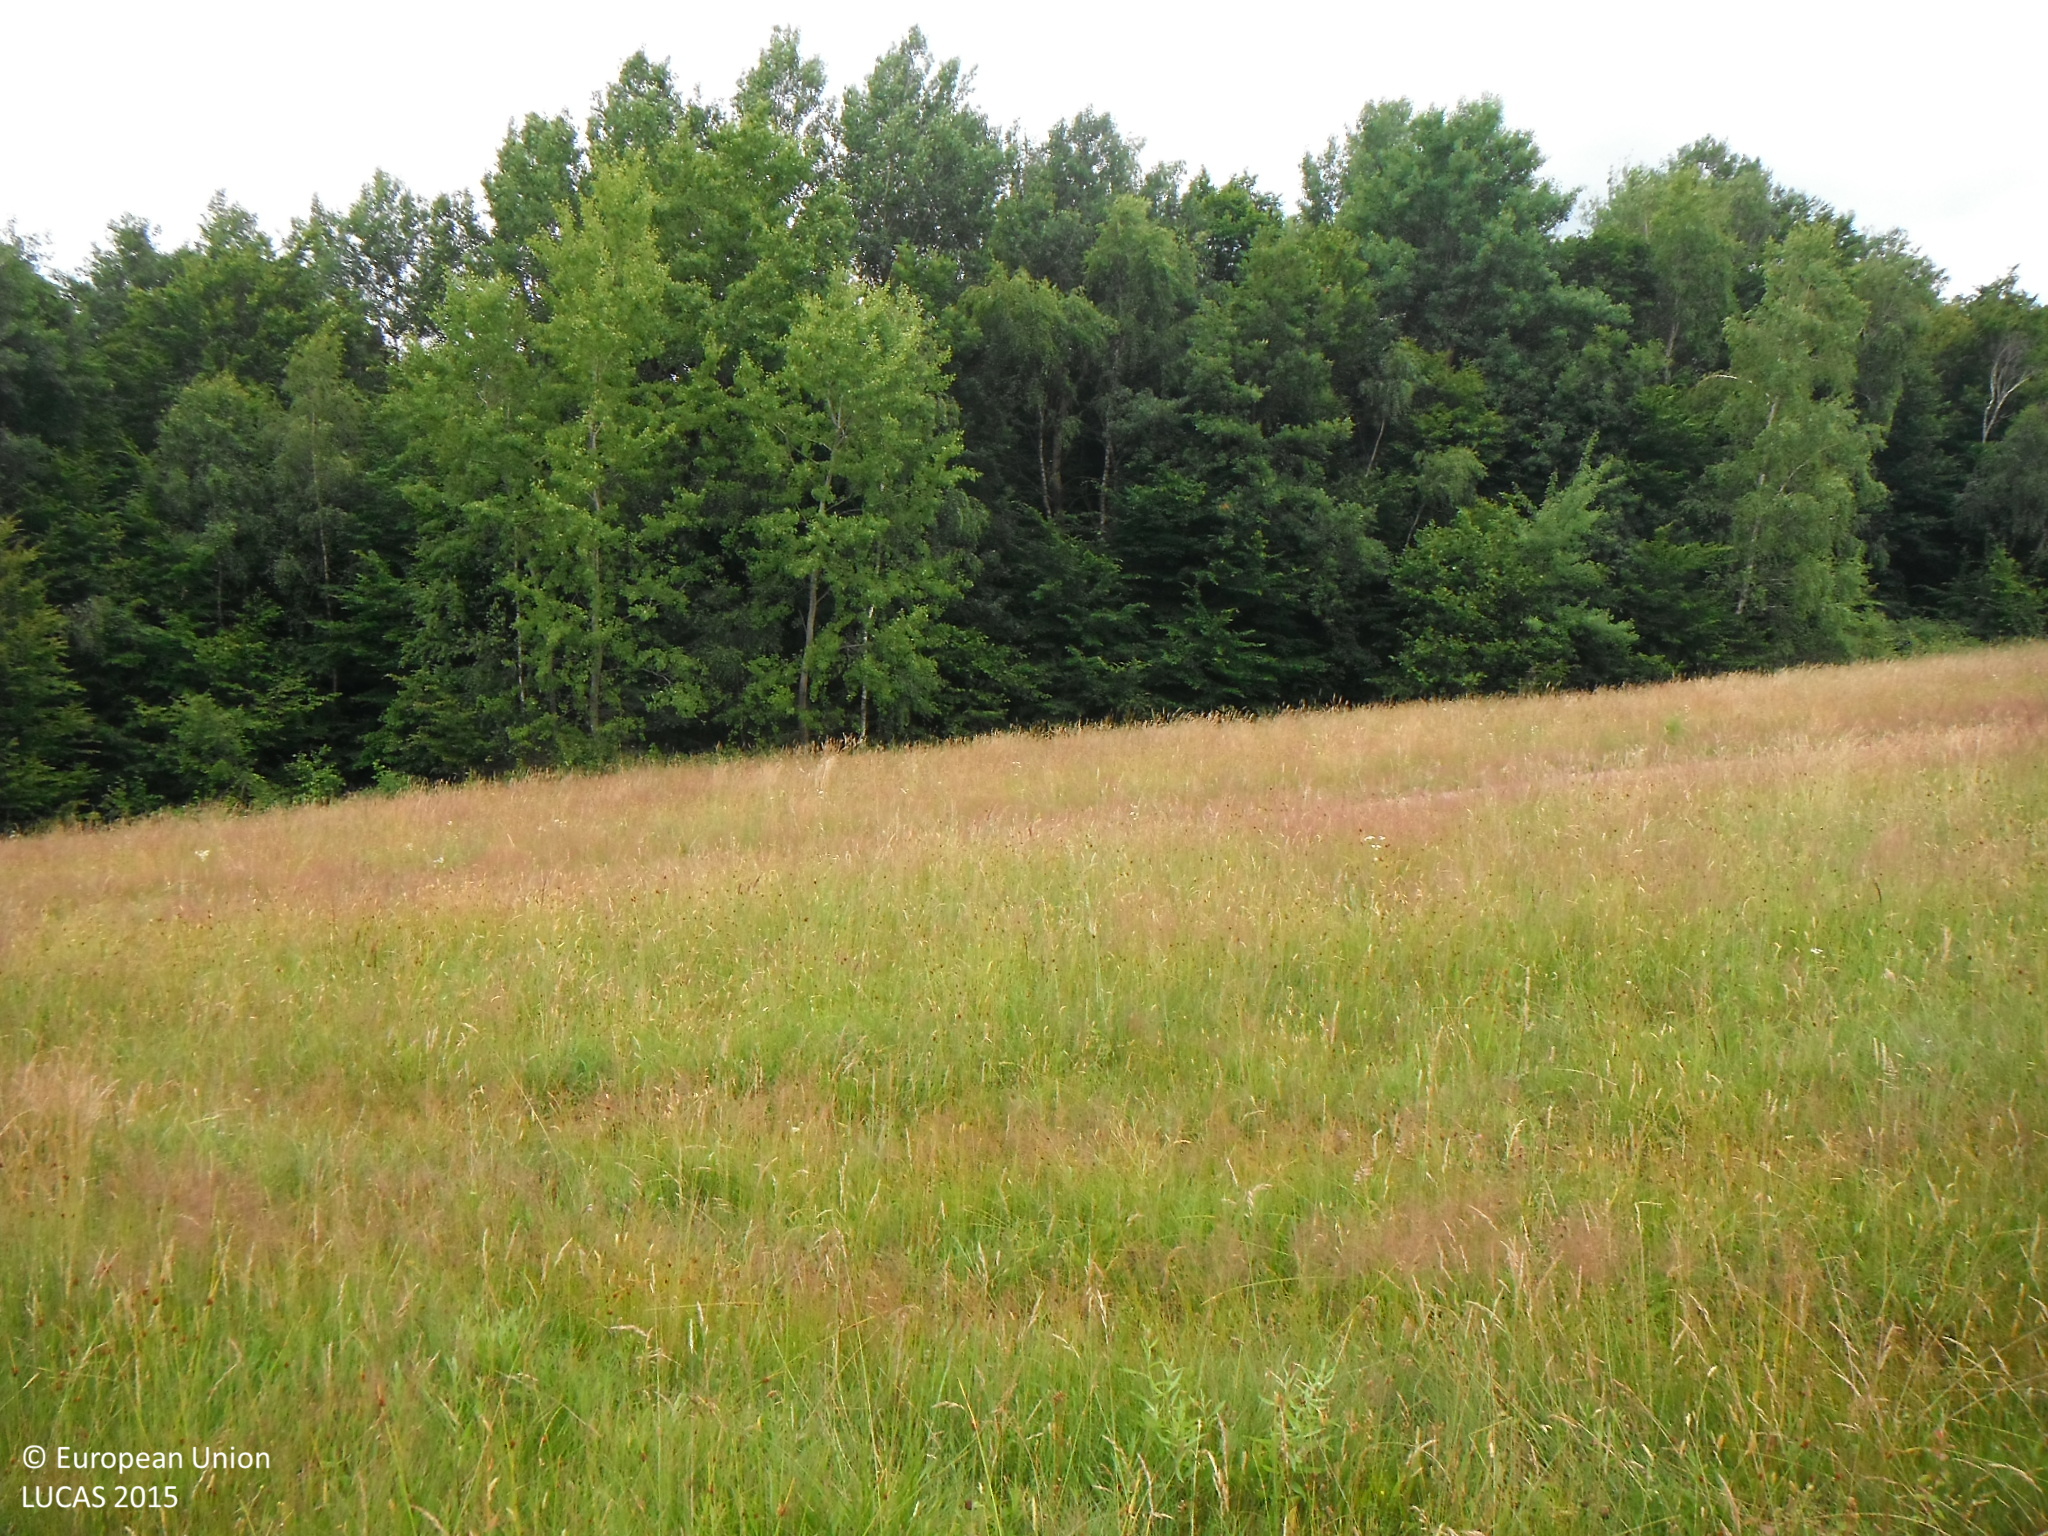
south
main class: Grassland
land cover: Grassland without tree/shrub cover
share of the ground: > 75 %
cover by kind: herbaceous plants 100 %
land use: Agriculture (excluding fallow land and kitchen gardens)
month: June
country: SK
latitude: 49.0034
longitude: 21.9891
